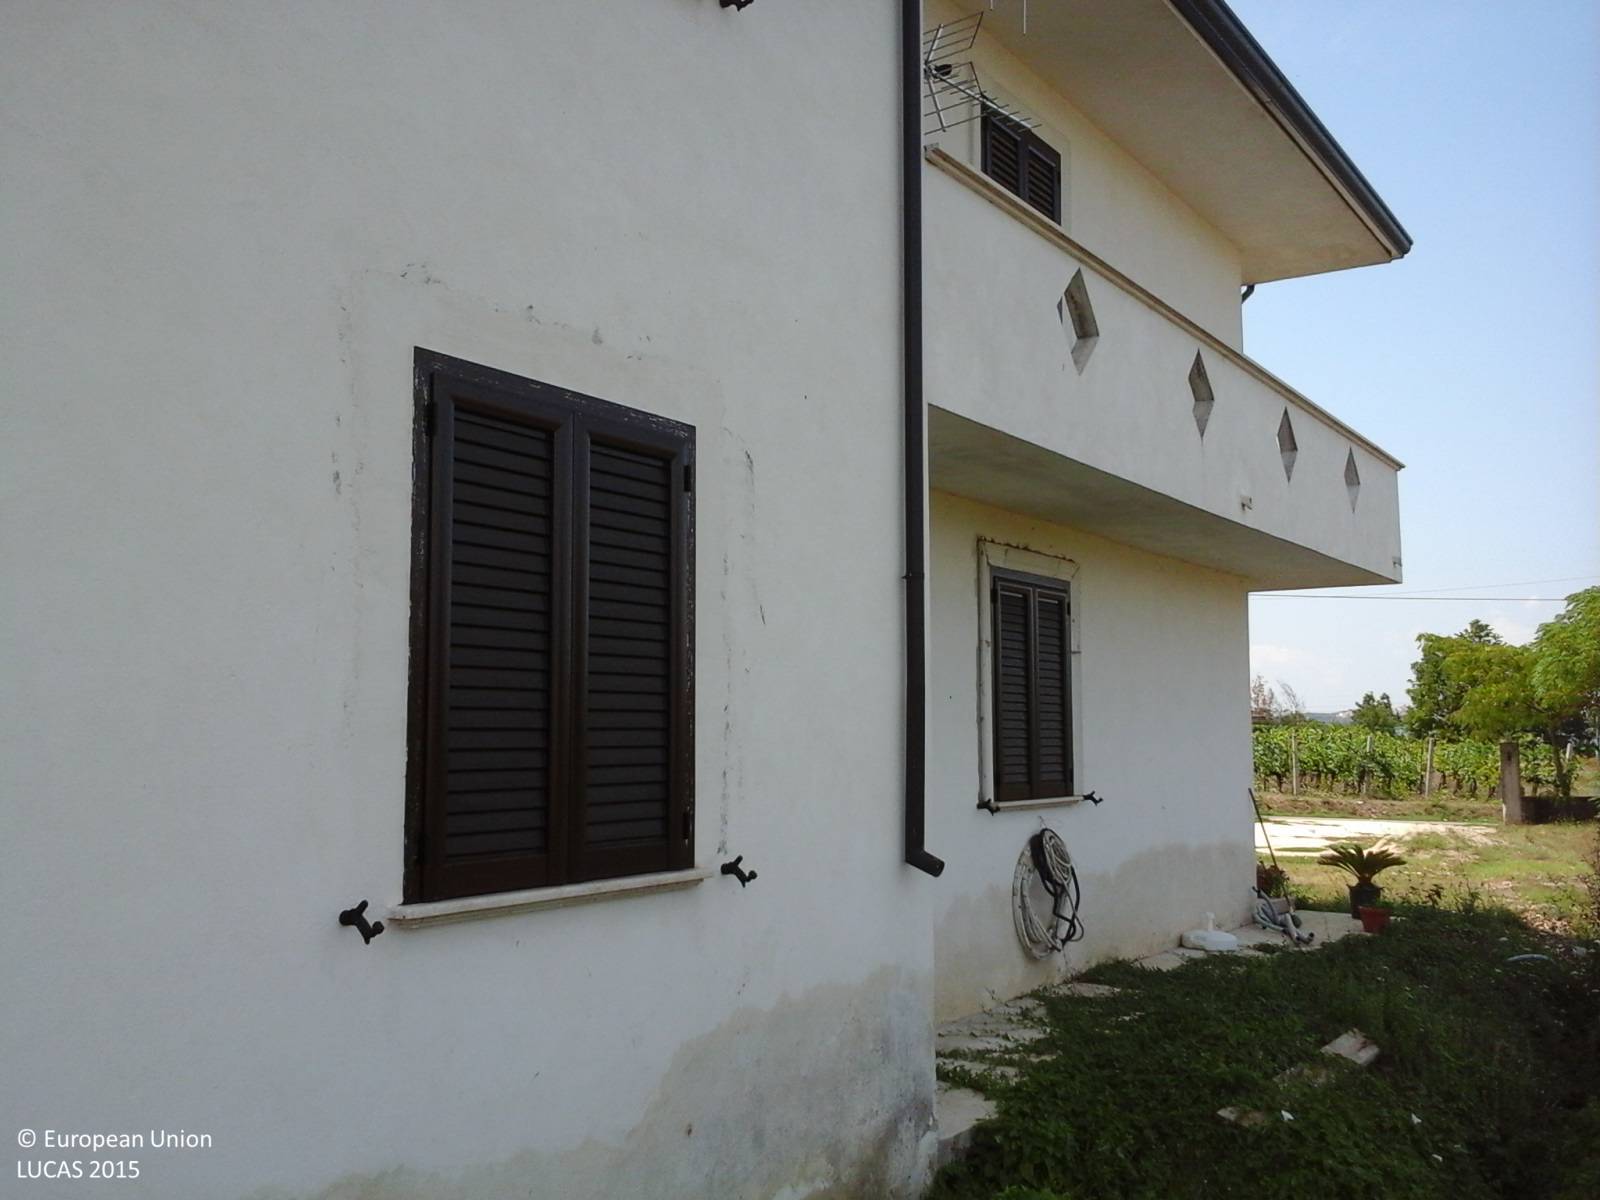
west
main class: Cropland
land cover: Vineyards
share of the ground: > 75 %
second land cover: Spontaneously vegetated surfaces
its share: > 75 %
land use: Agriculture (excluding fallow land and kitchen gardens)
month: August
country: IT
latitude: 41.5307
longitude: 13.3788
